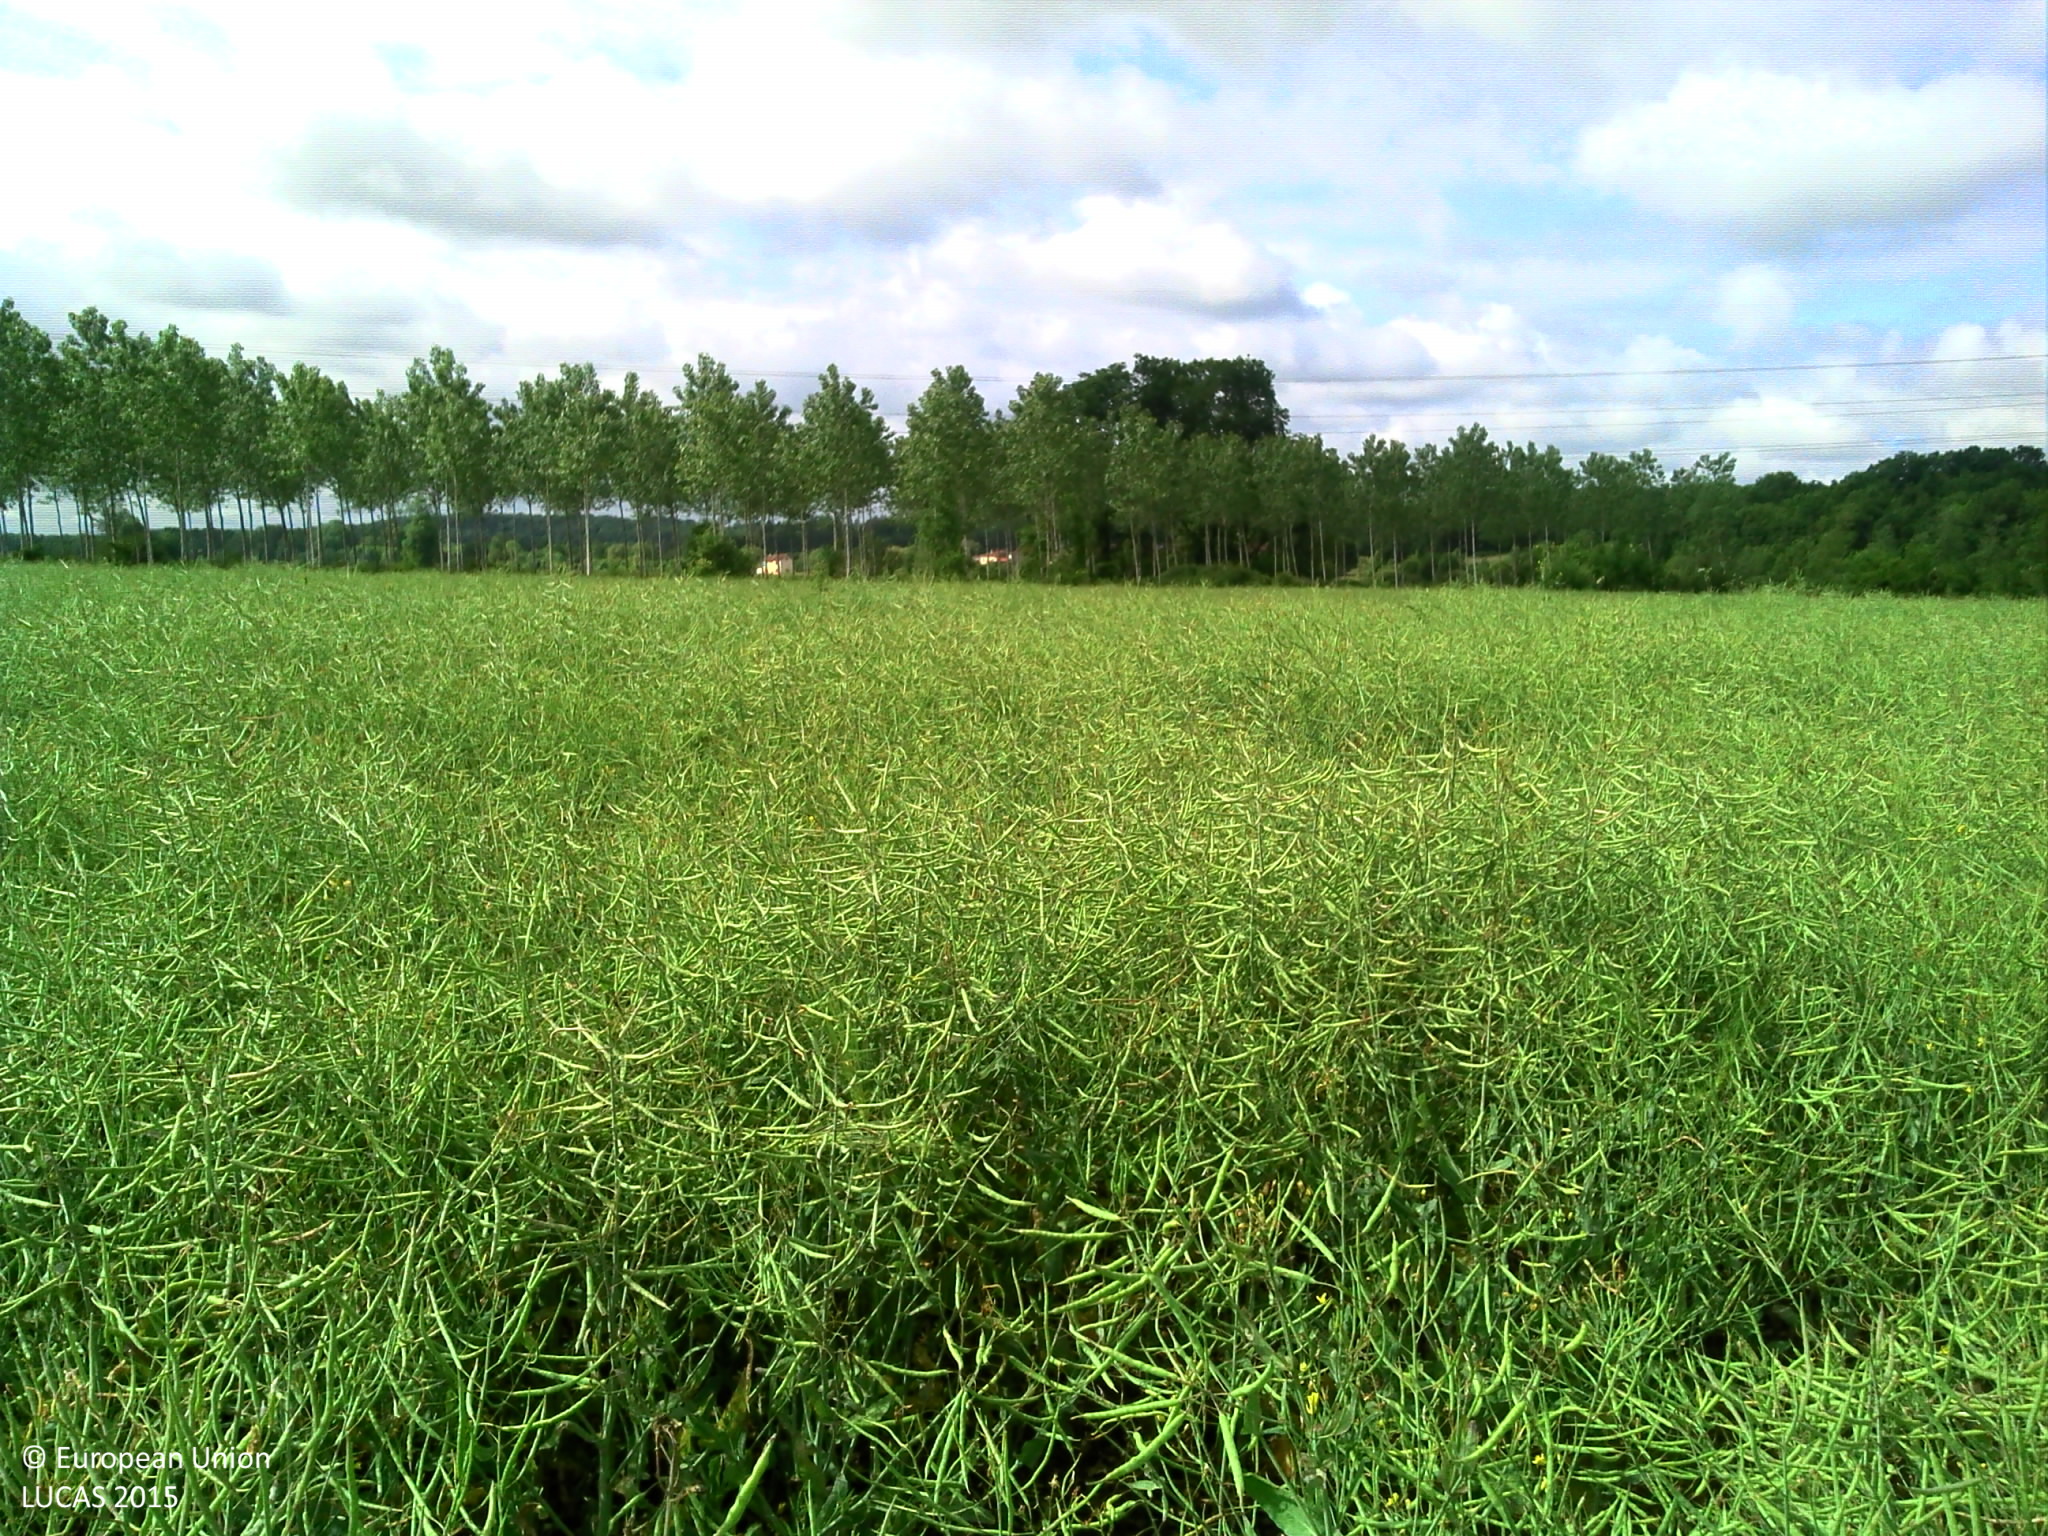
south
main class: Cropland
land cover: Rape and turnip rape
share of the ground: > 75 %
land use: Agriculture (excluding fallow land and kitchen gardens)
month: June
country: FR
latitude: 48.5212
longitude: 4.9210
